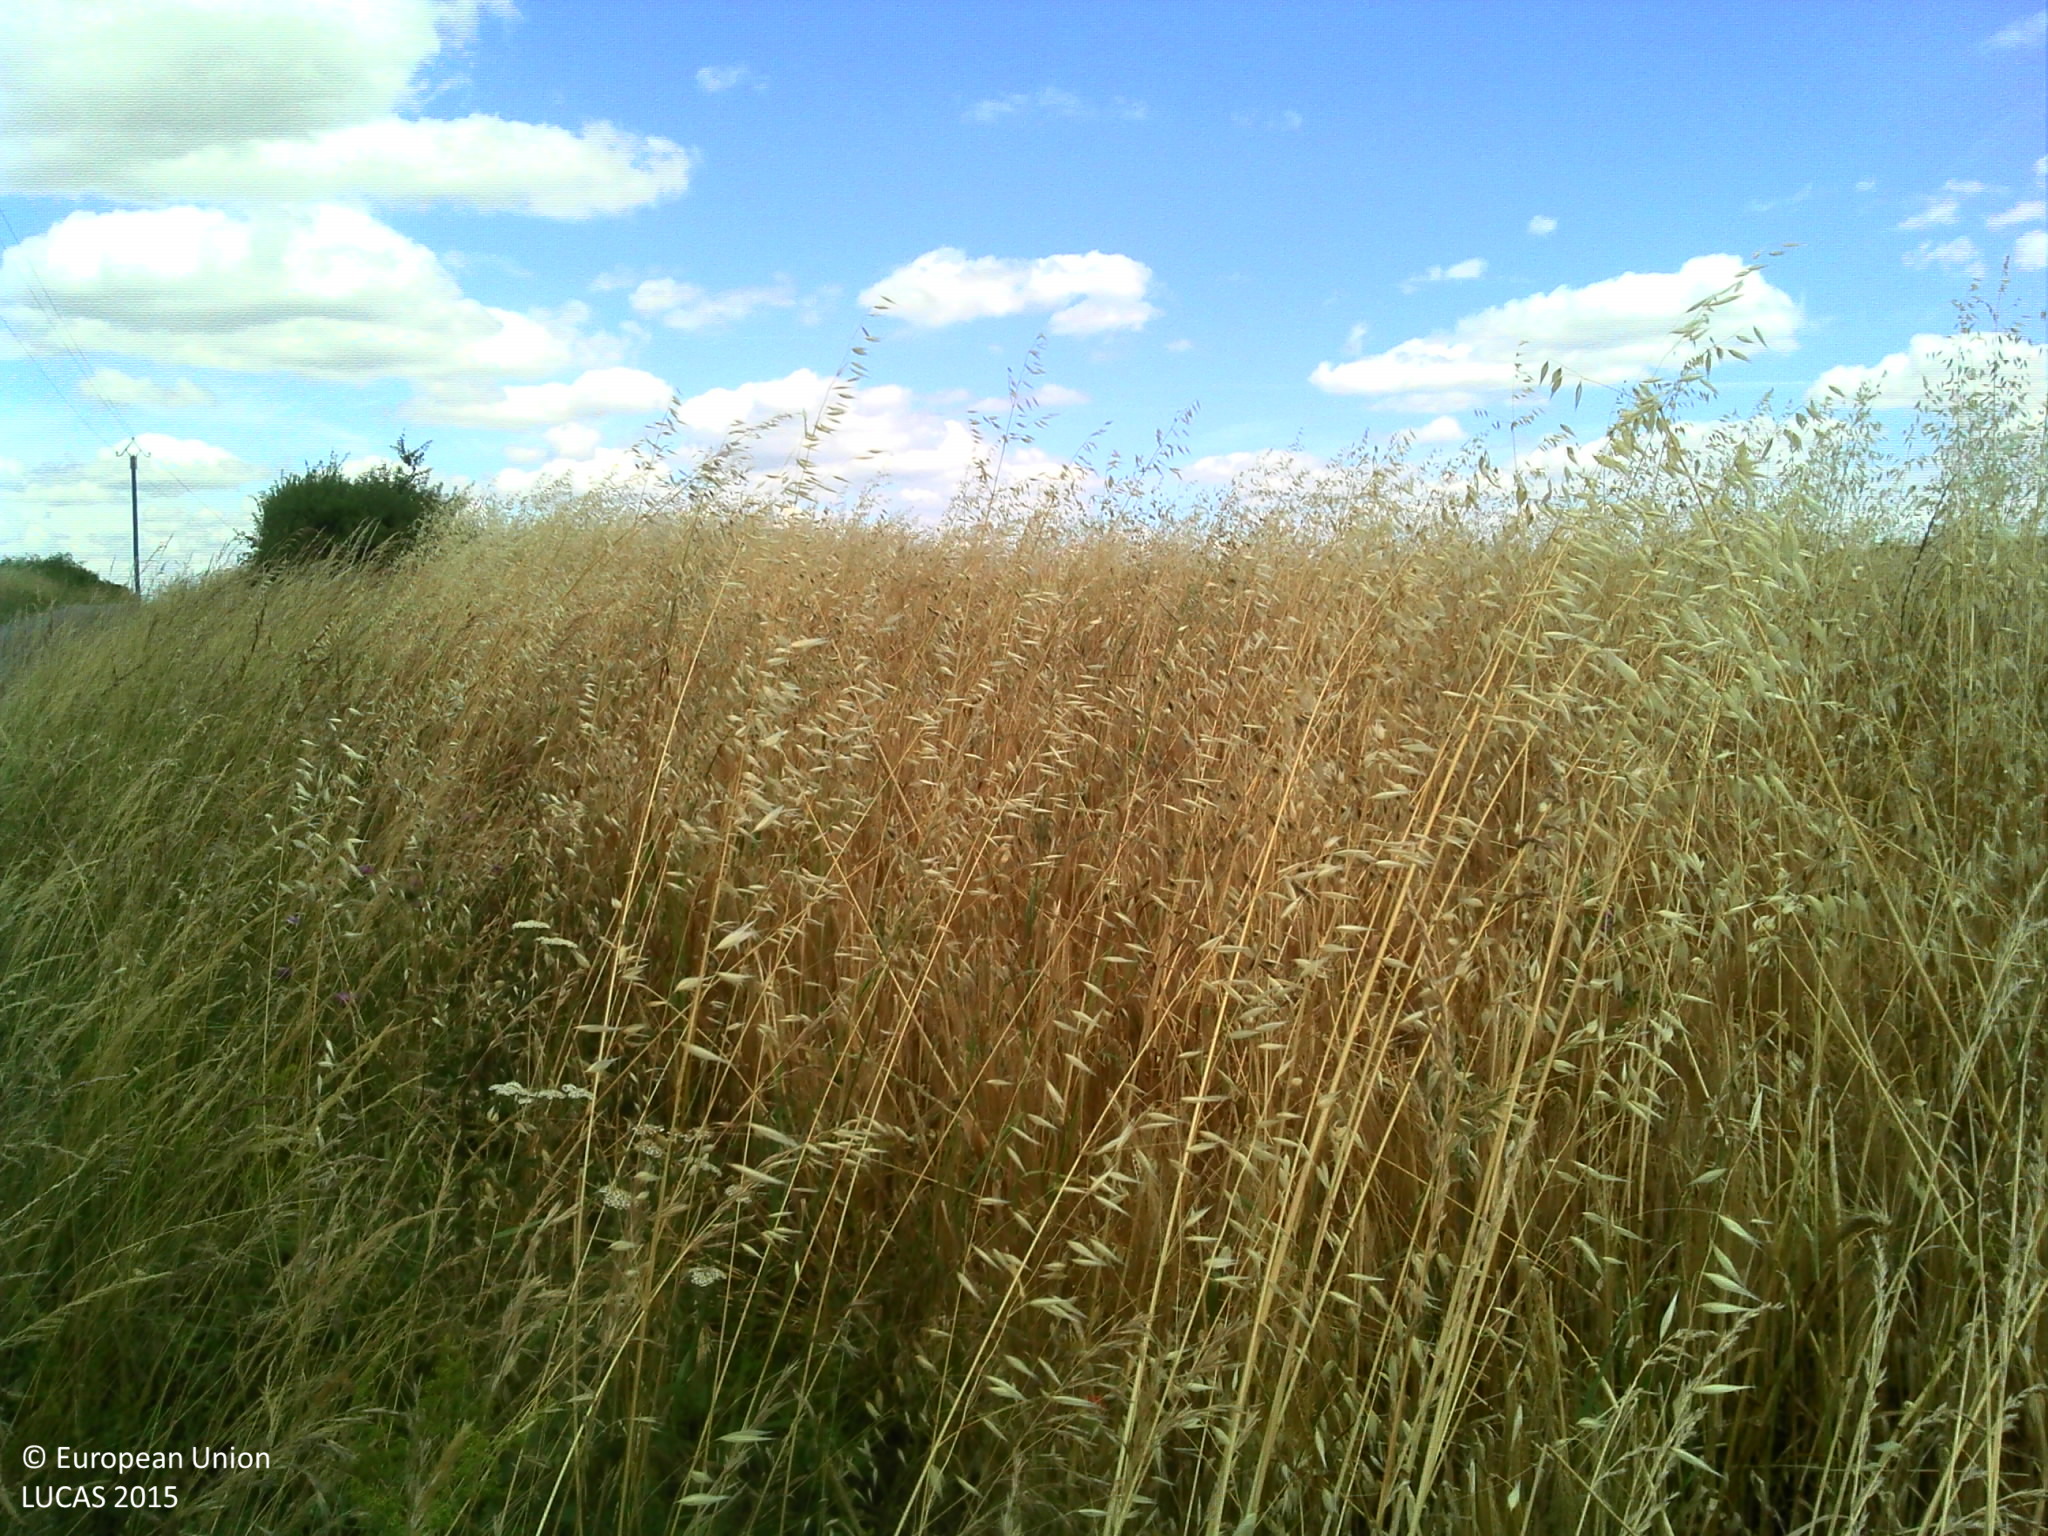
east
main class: Cropland
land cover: Barley
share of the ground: 50 - 75 %
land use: Agriculture (excluding fallow land and kitchen gardens)
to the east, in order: Barley; Grassland without tree/shrub cover; Fences; Grassland without tree/shrub cover; Fences; Grassland without tree/shrub cover; Abandoned hedges; Barley
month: June
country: FR
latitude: 44.1254
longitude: 1.9163
